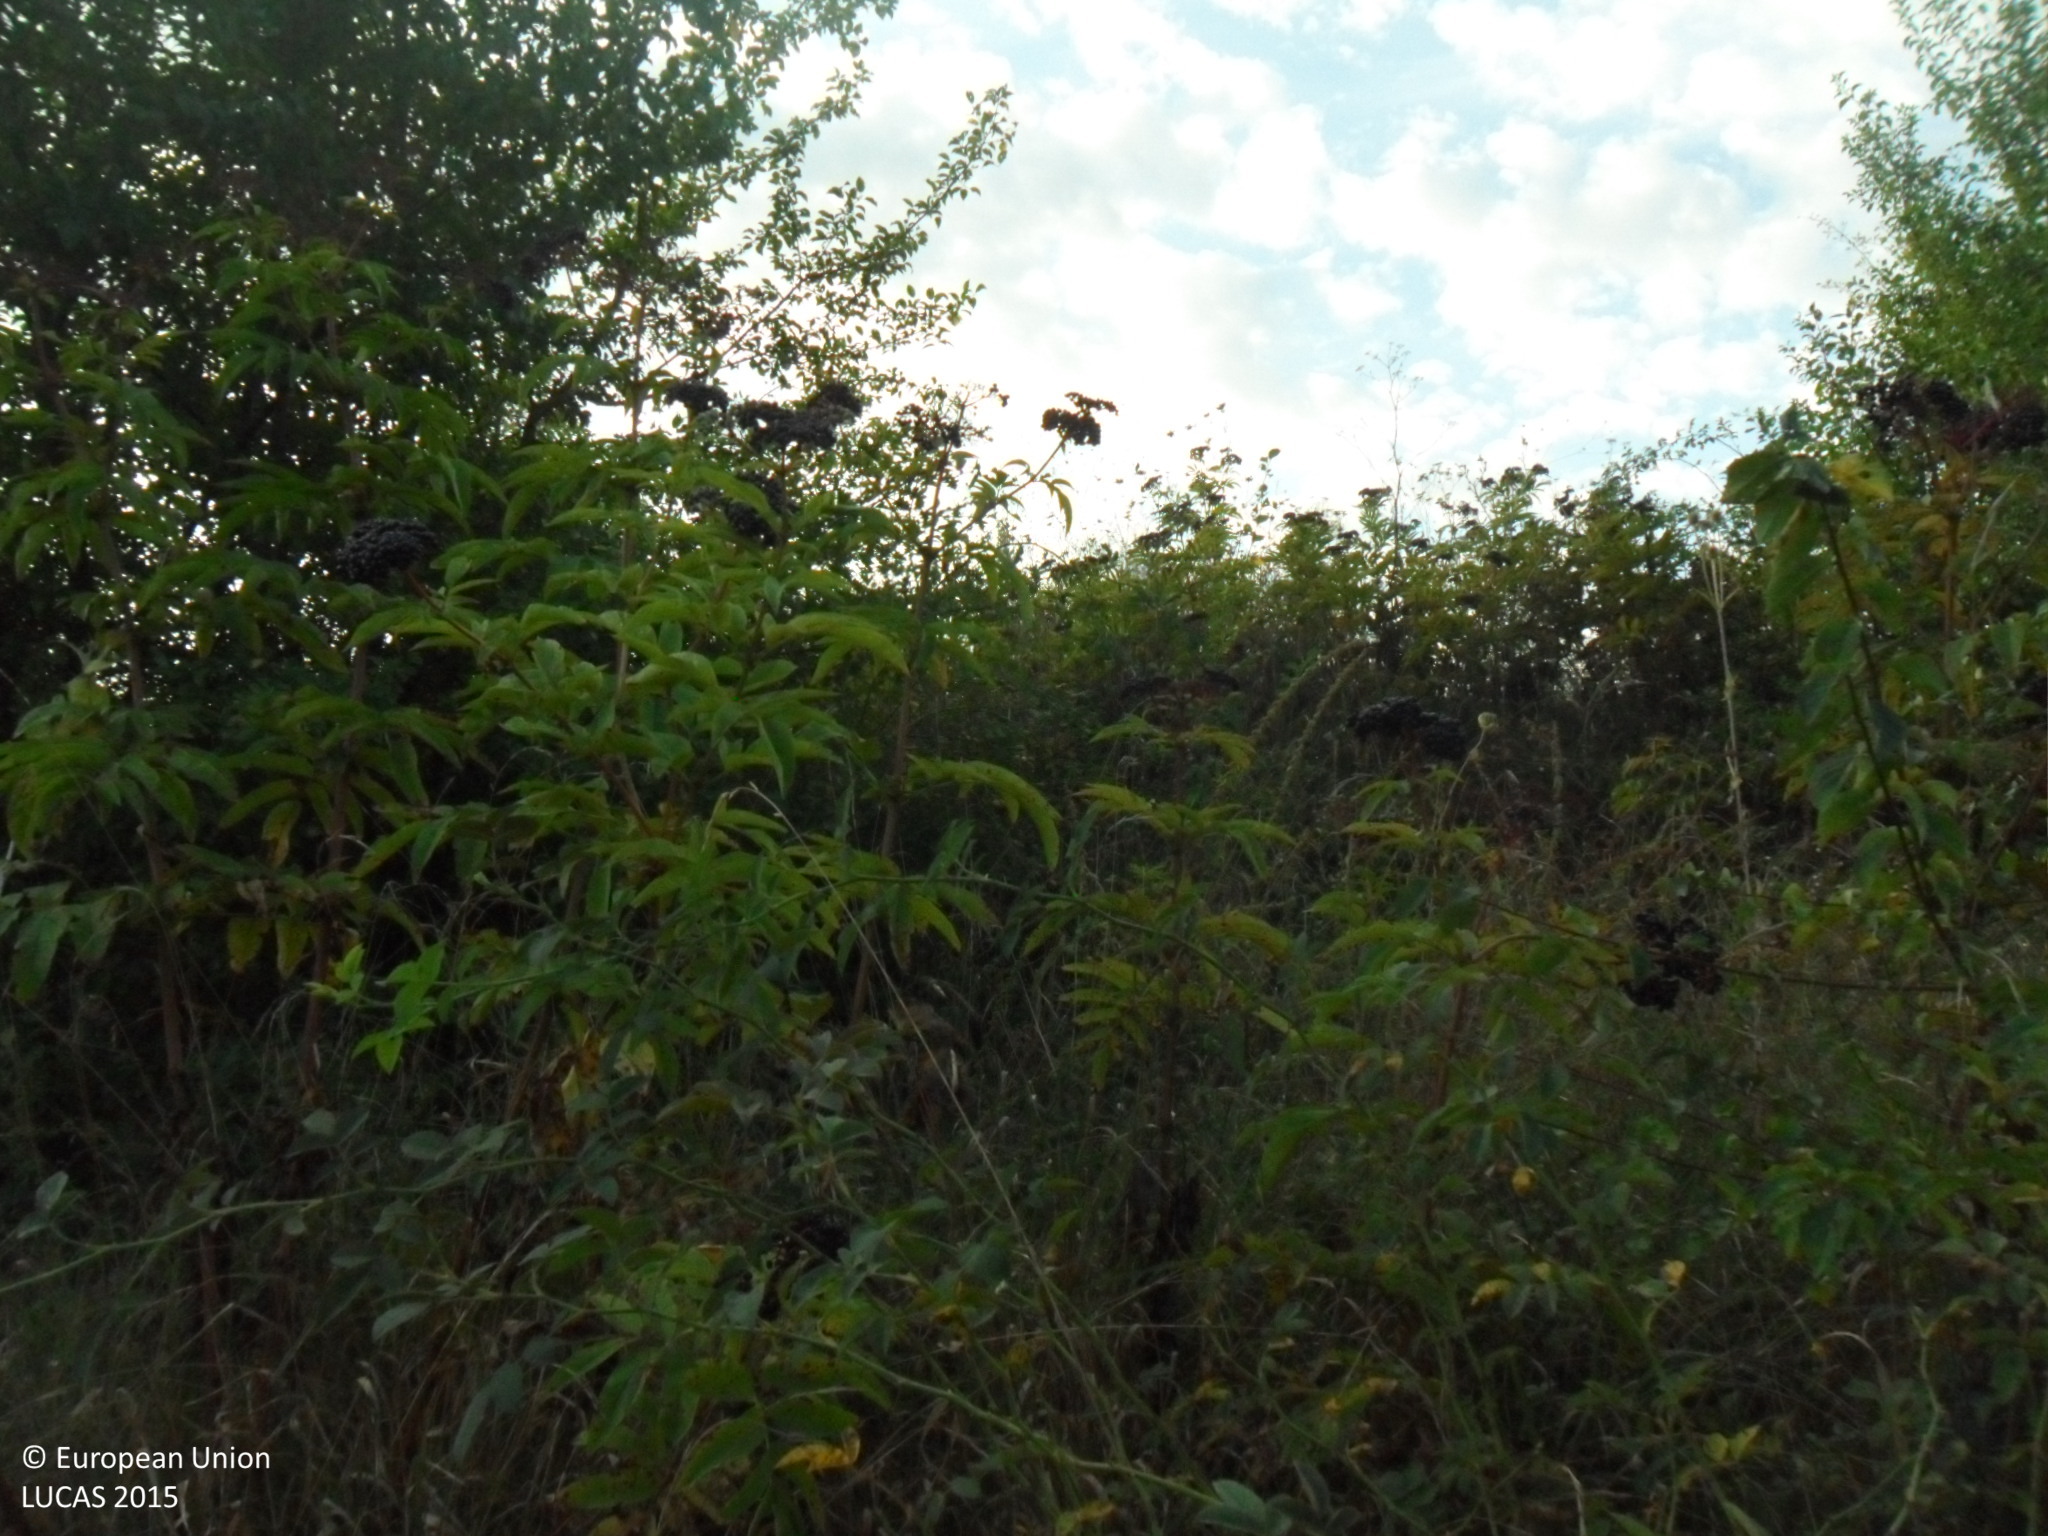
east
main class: Shrubland
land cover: Shrubland with sparse tree cover
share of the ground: > 75 %
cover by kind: shrubs 80 %, herbaceous plants 15 %, broadleaved forest trees 5 %
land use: Agriculture (excluding fallow land and kitchen gardens)
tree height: < 5 m
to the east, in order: Shrubland with sparse tree cover; Common wheat
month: September
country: BG
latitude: 43.6289
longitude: 26.2492
